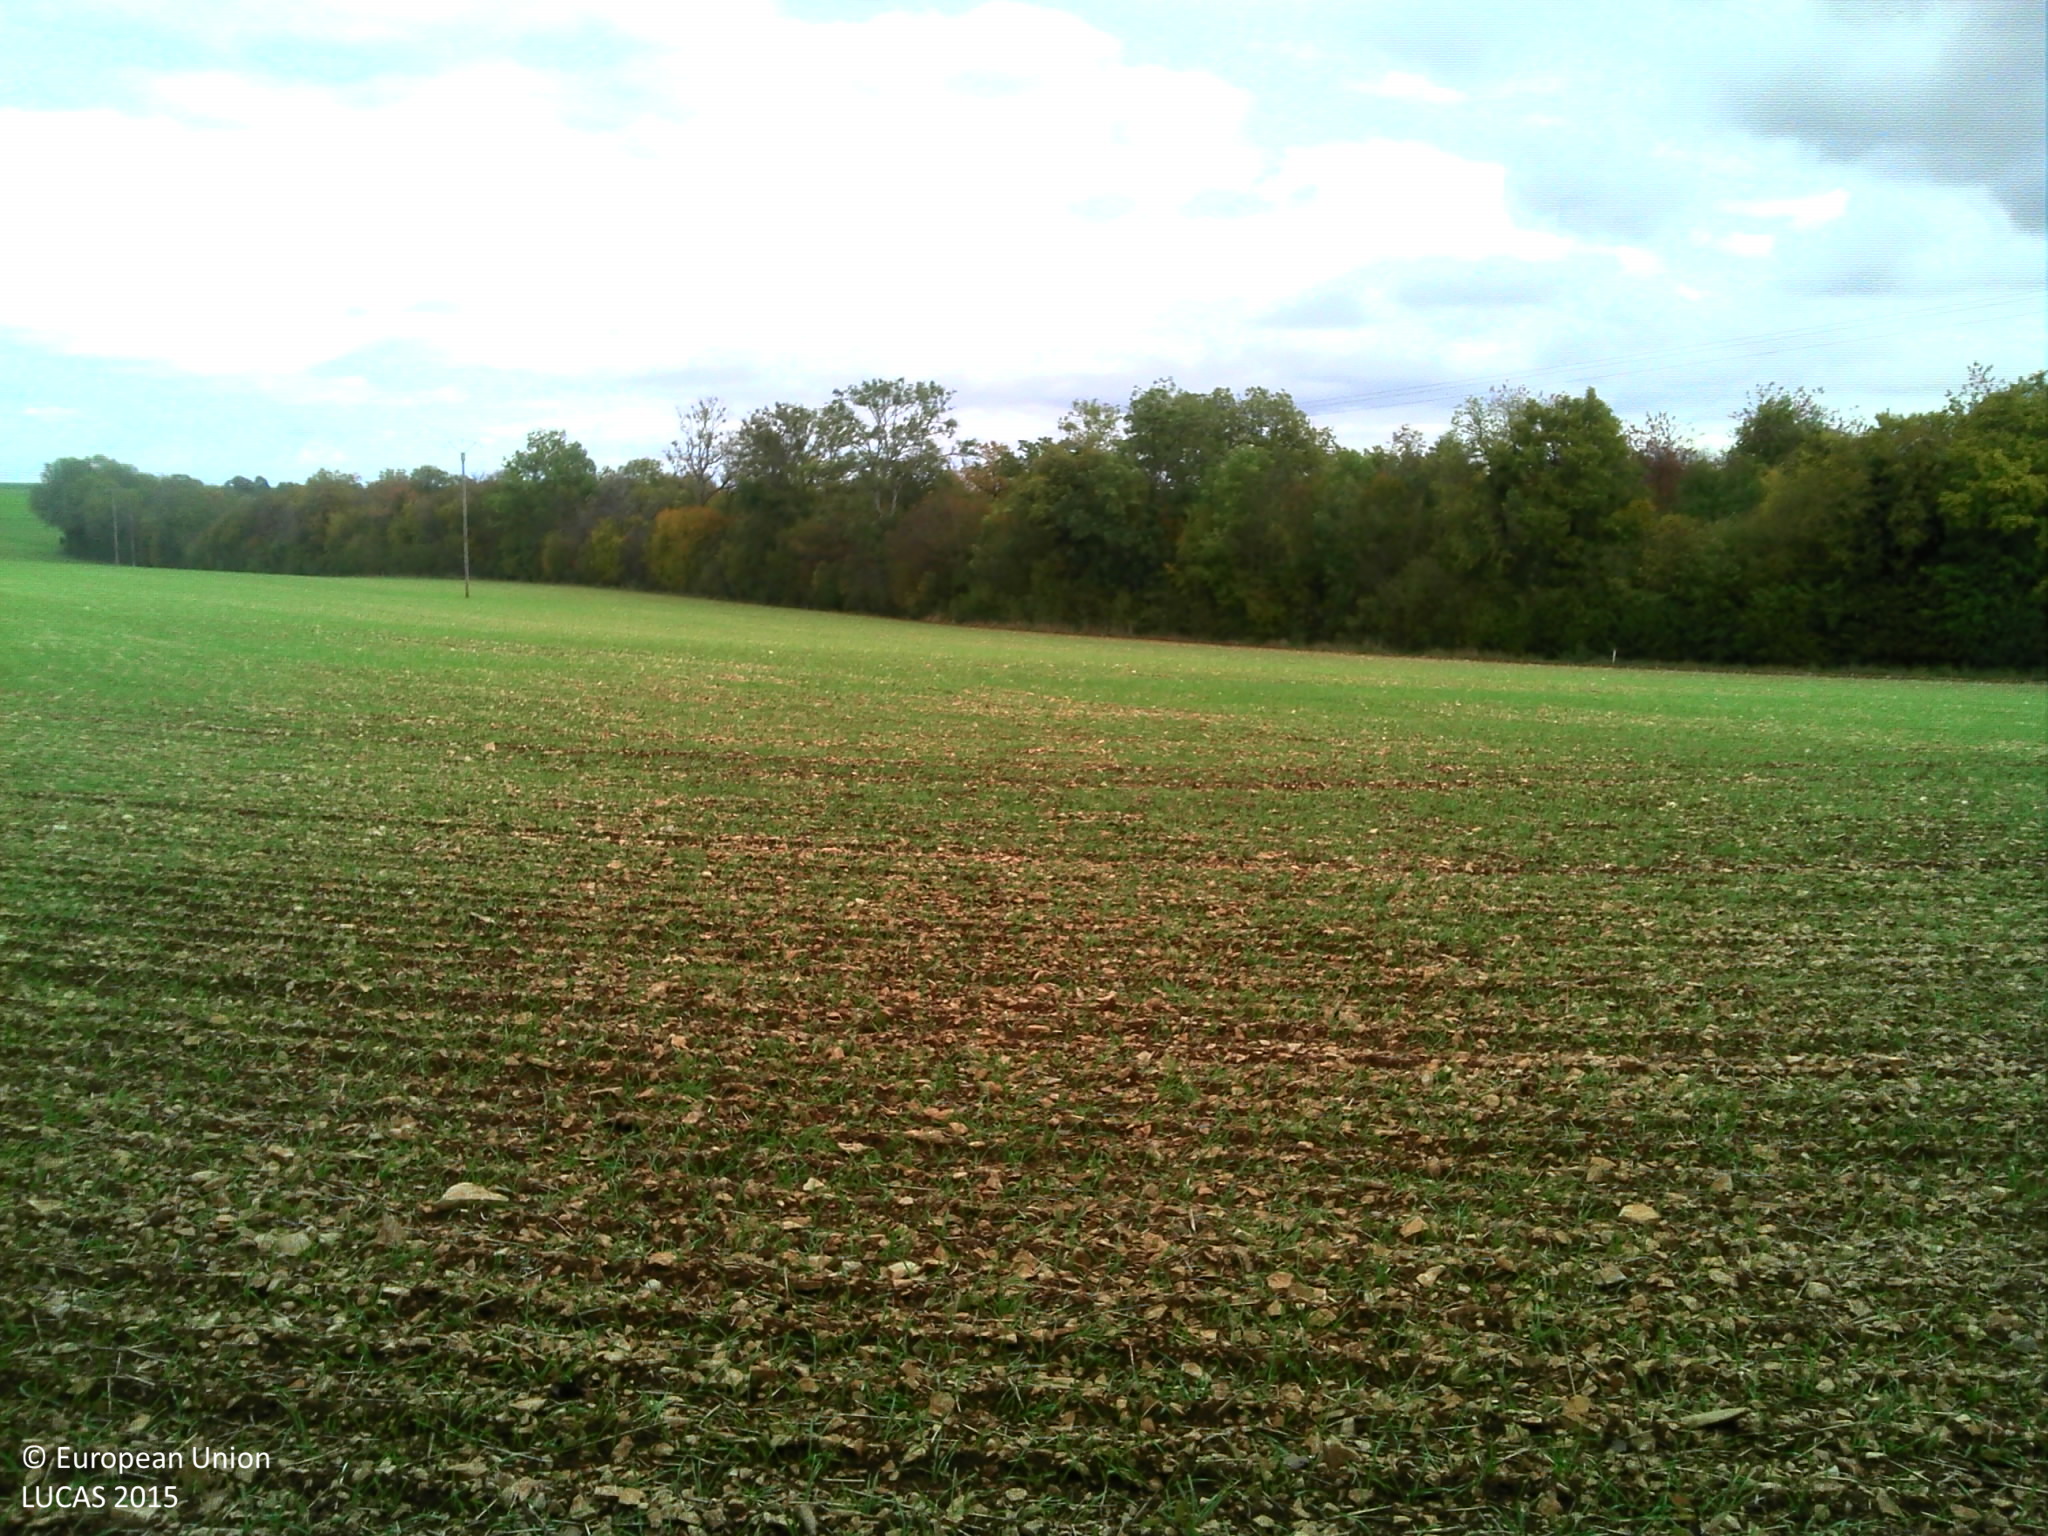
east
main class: Woodland
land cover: Broadleaved woodland
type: mesophytic deciduous forest
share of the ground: > 75 %
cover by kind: broadleaved forest trees 100 %
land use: Semi-natural and natural areas not in use
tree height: > 5 m
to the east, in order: Broadleaved woodland; Temporary grasslands; Electric lines; Temporary grasslands; Grass margins; Broadleaved woodland
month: October
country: FR
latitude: 47.4585
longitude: 4.9462
